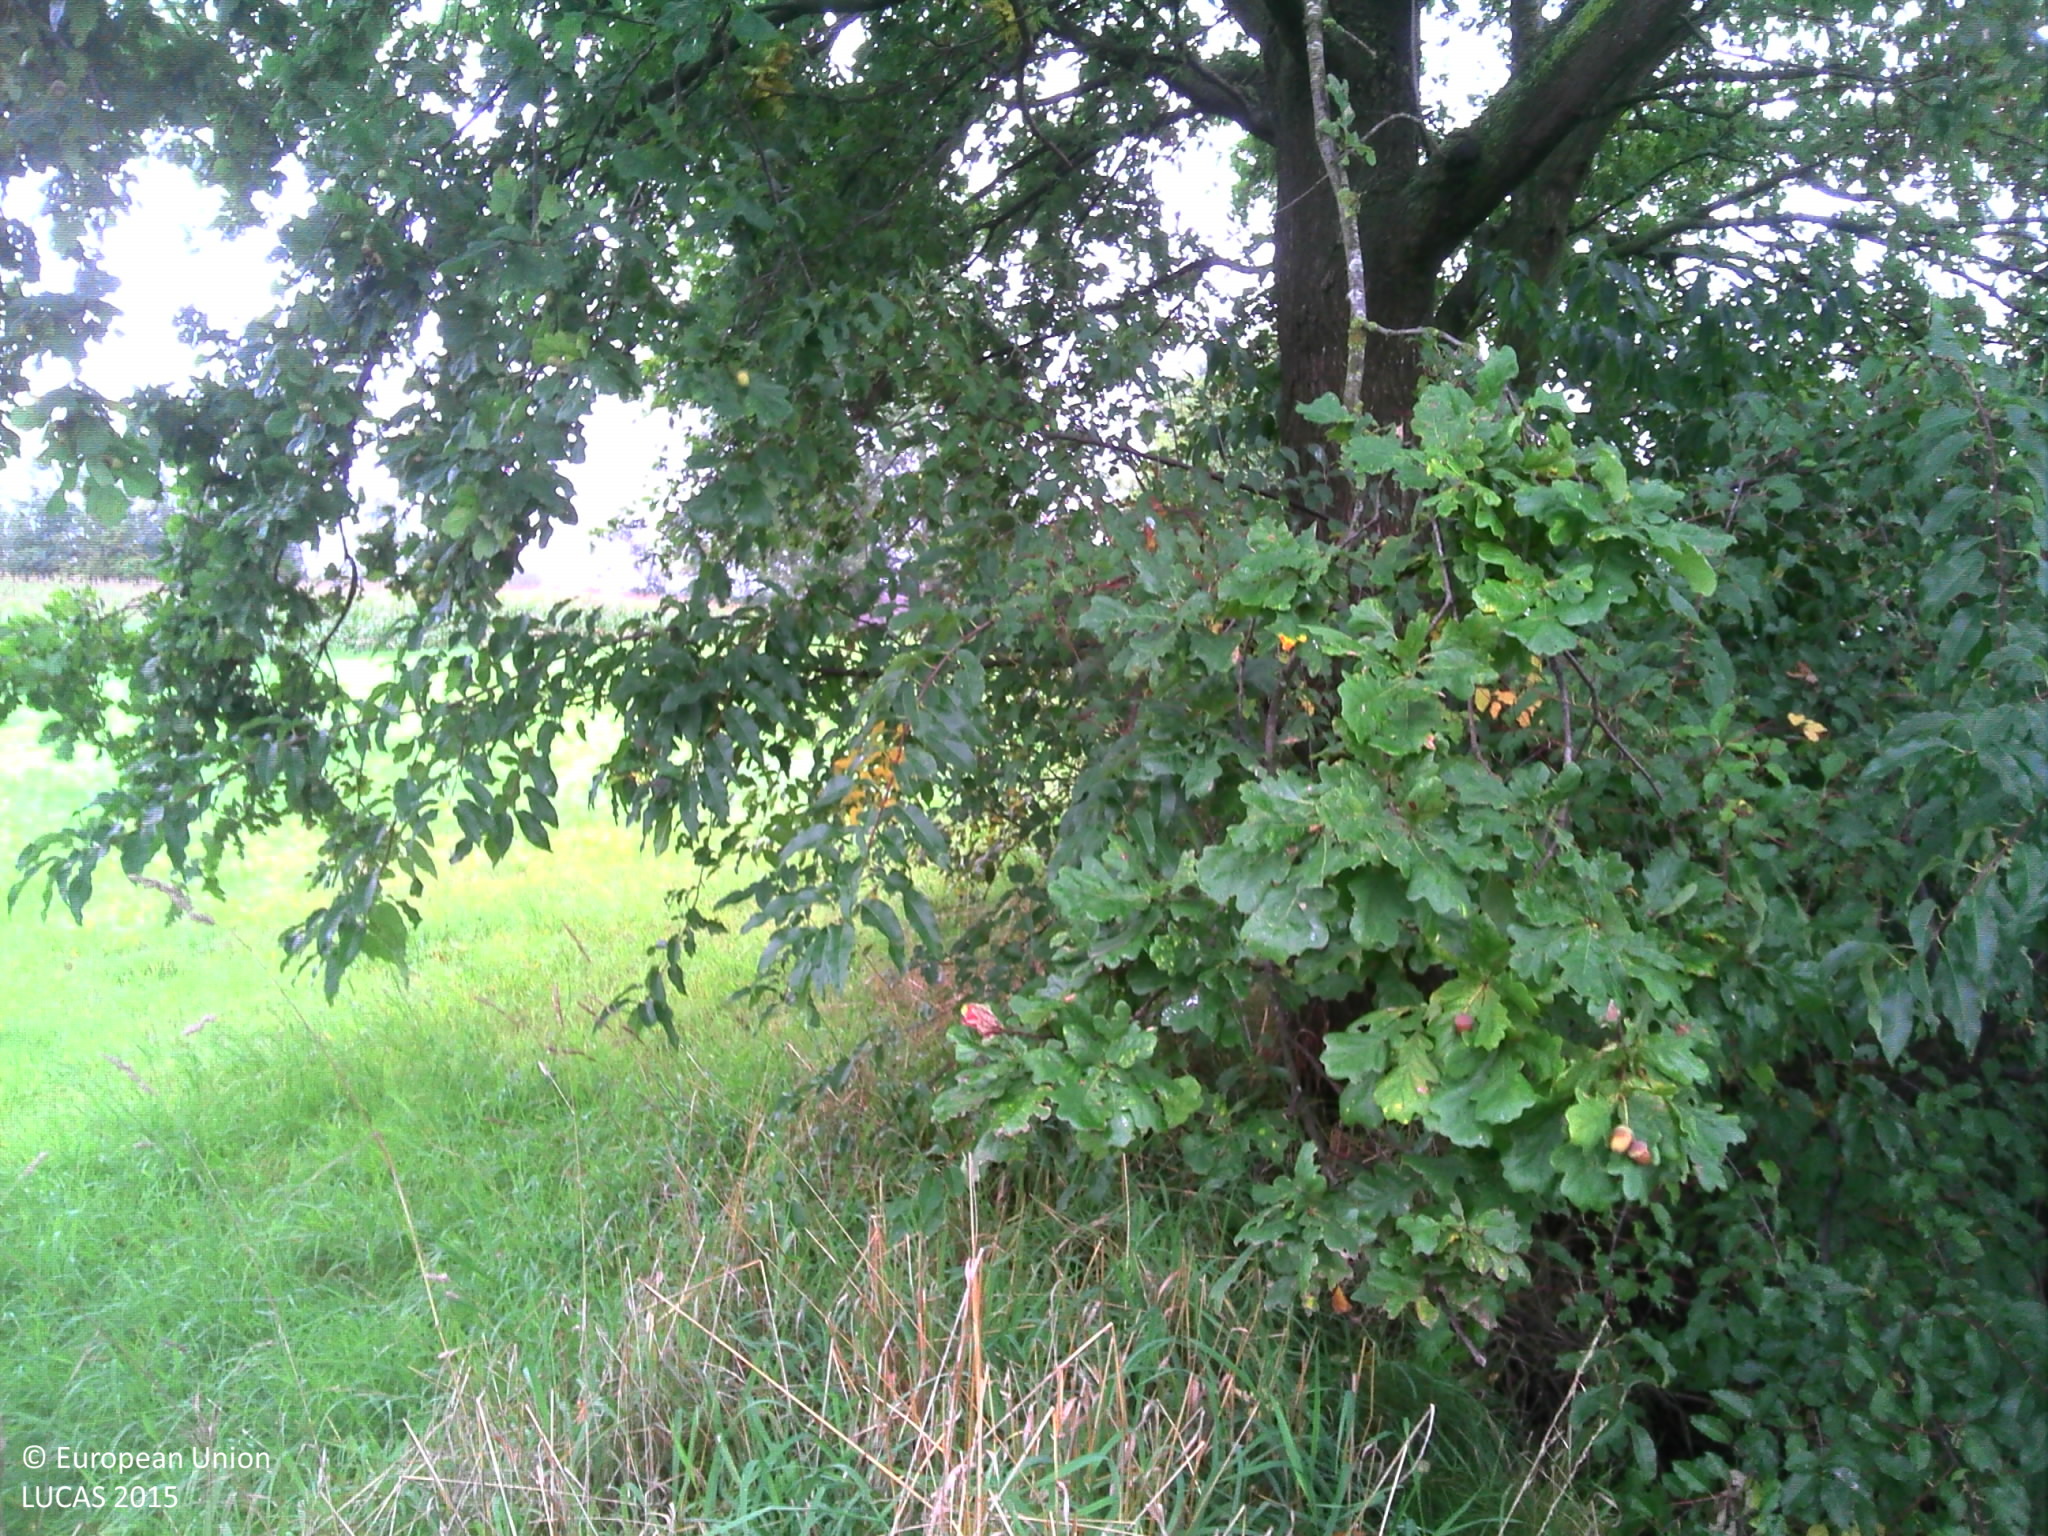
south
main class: Grassland
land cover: Grassland without tree/shrub cover
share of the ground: > 75 %
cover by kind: herbaceous plants 100 %
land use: Agriculture (excluding fallow land and kitchen gardens)
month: October
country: BE
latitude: 51.1291
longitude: 4.8095
